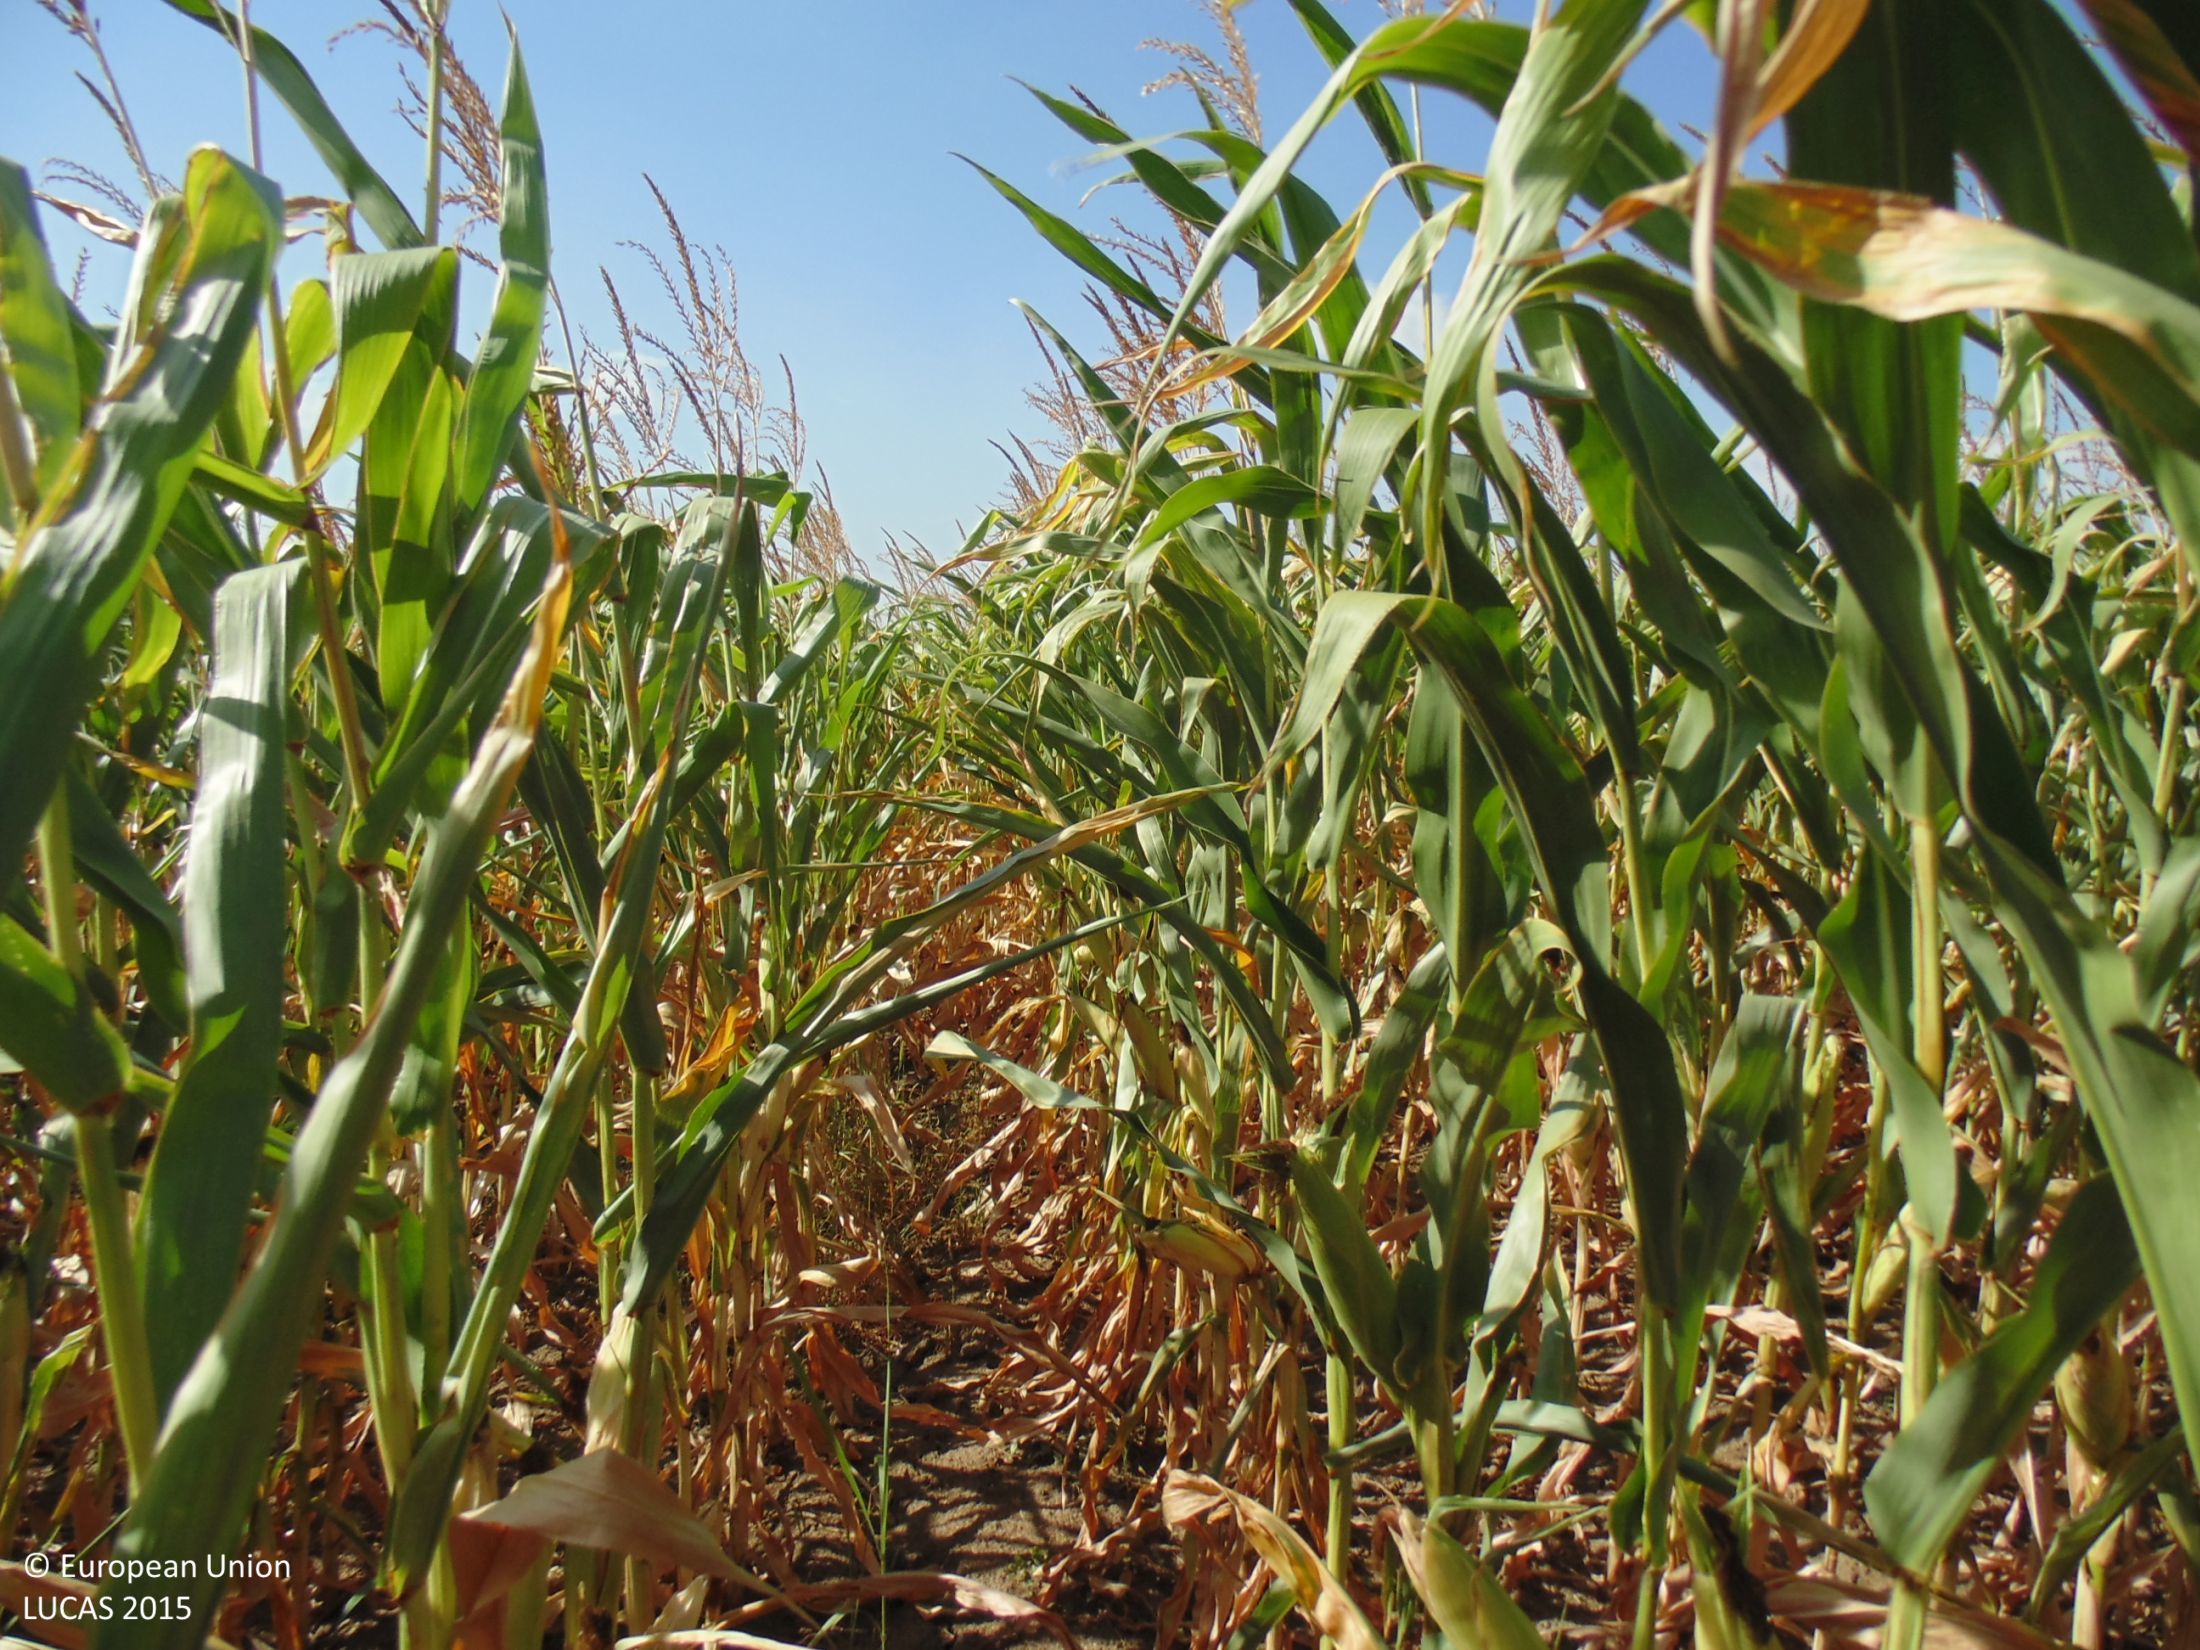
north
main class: Cropland
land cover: Maize
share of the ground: > 75 %
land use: Agriculture (excluding fallow land and kitchen gardens)
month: August
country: BG
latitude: 43.7867
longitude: 27.7245
